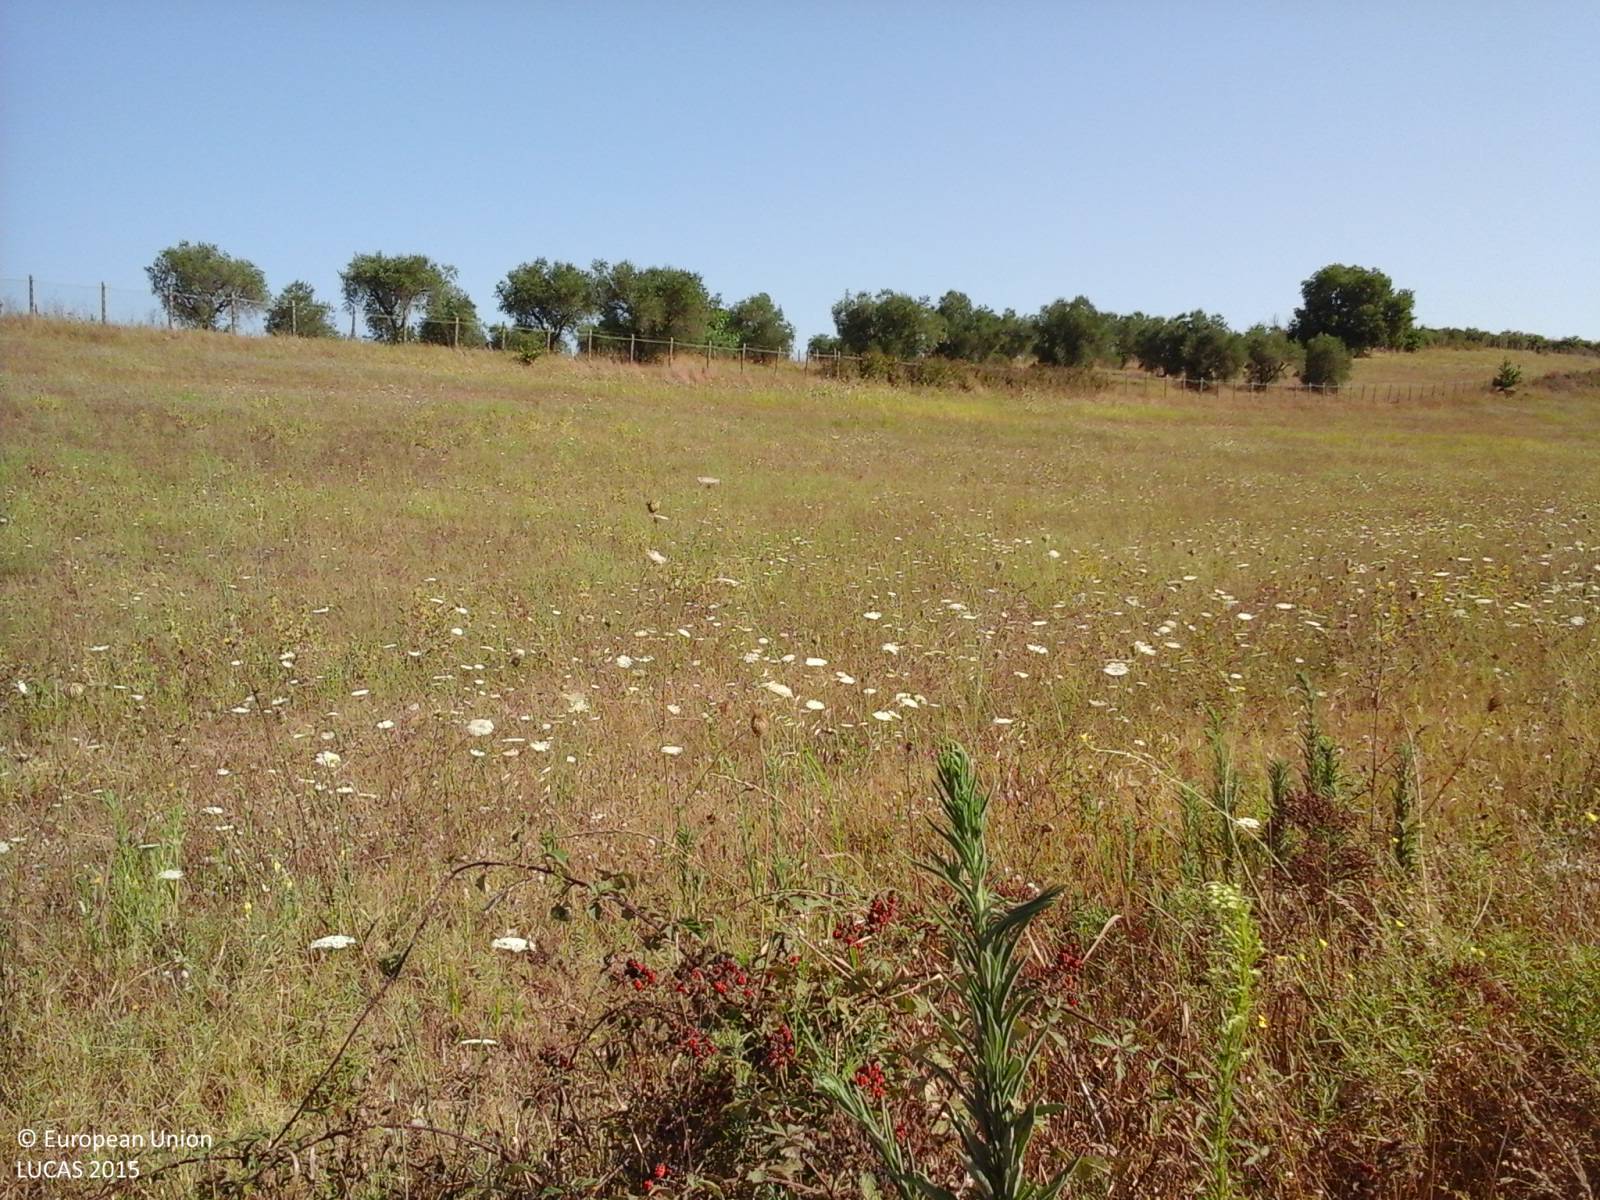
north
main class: Cropland
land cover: Mixed cereals for fodder
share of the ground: > 75 %
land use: Agriculture (excluding fallow land and kitchen gardens)
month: August
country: IT
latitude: 42.0852
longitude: 12.3247
